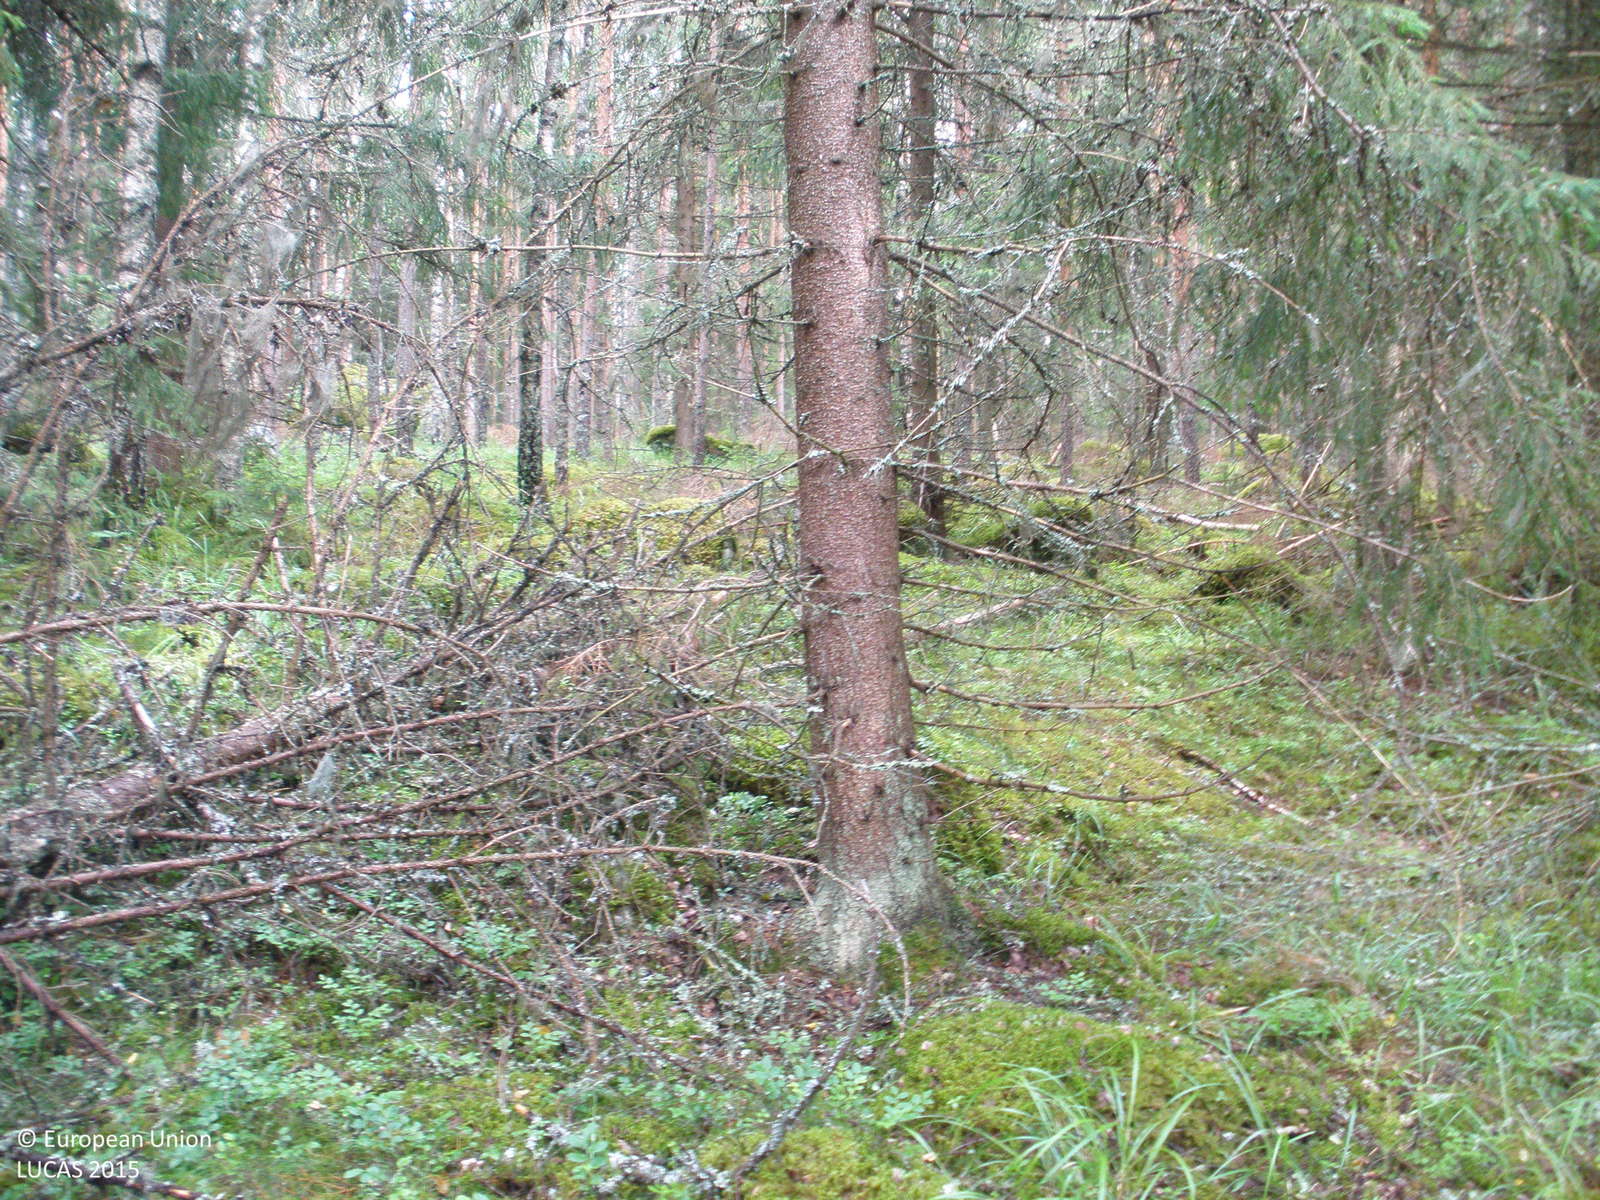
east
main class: Woodland
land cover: Spruce dominated mixed woodland
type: boreal forest
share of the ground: > 75 %
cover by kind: coniferous forest trees 60 %, broadleaved forest trees 30 %, herbaceous plants 5 %, lichens and mosses 5 %
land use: Forestry
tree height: > 5 m
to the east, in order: Spruce dominated mixed woodland; Pine dominated mixed woodland; Spruce dominated mixed woodland
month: July
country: FI
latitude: 61.4257
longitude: 23.1751
